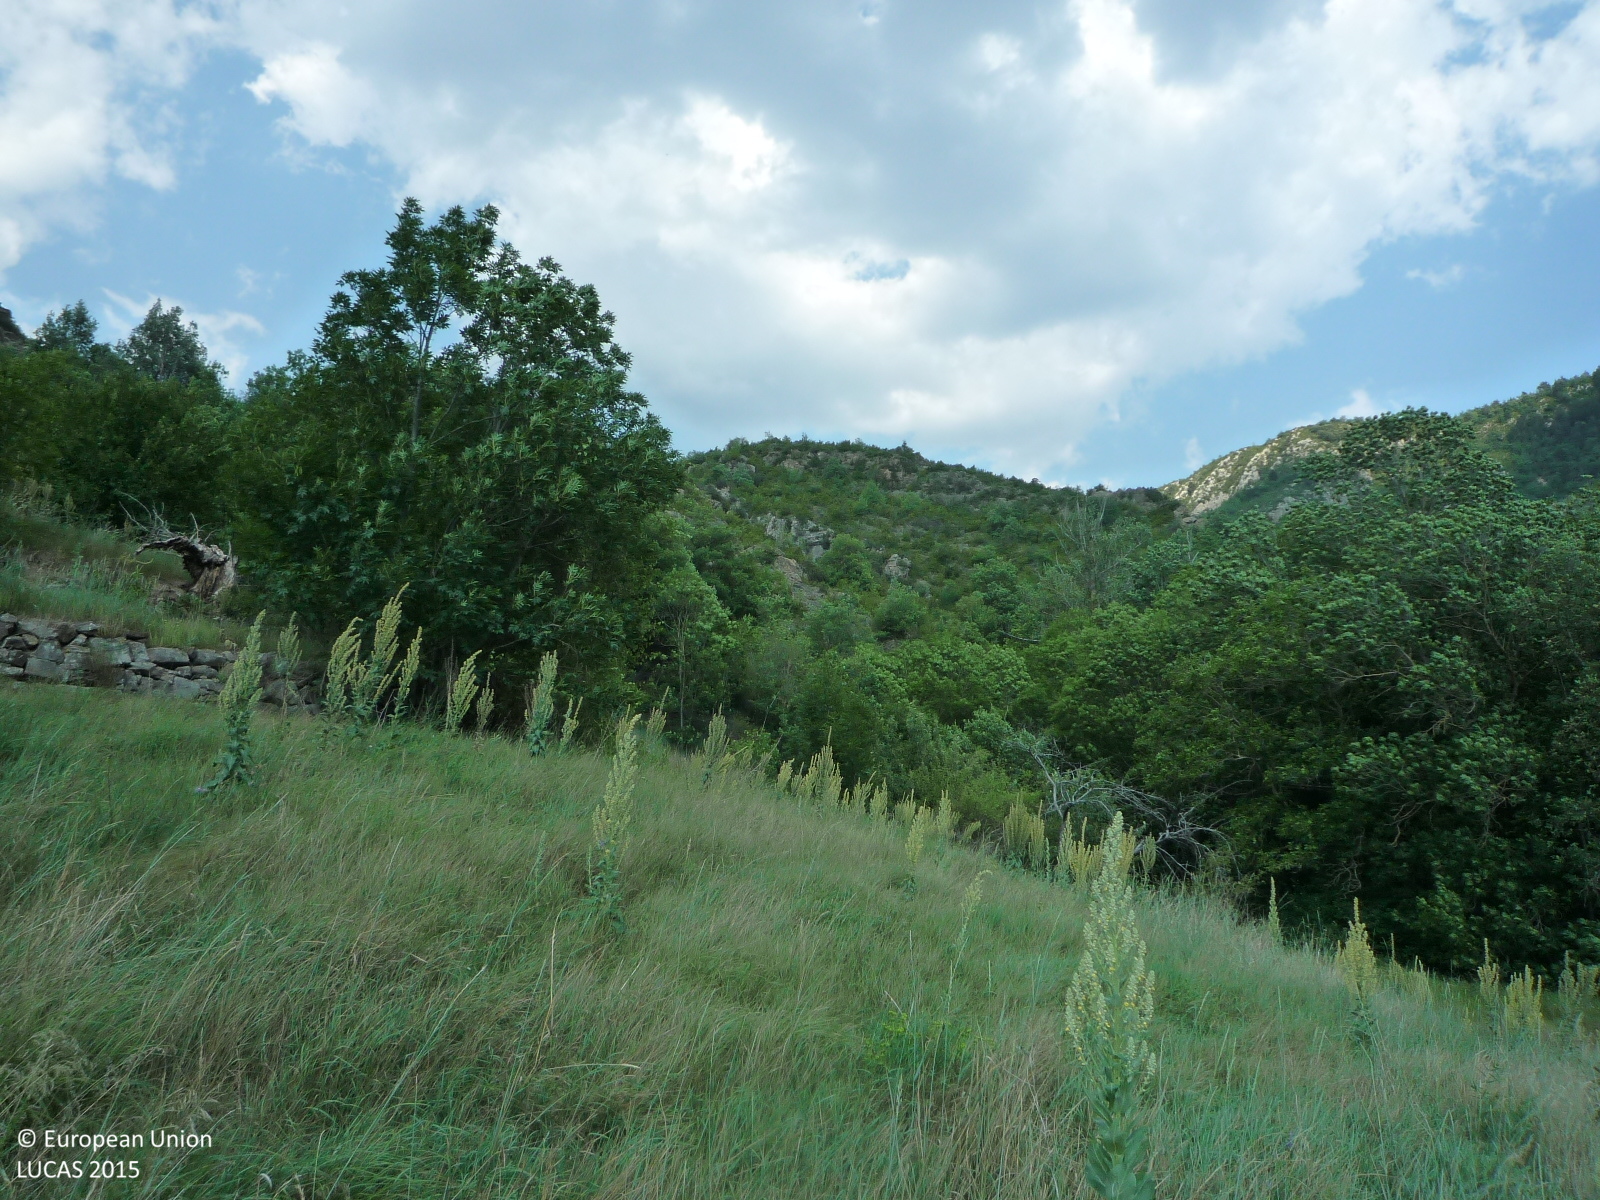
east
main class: Woodland
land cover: Broadleaved woodland
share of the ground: > 75 %
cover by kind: broadleaved forest trees 70 %, shrubs 30 %
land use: Semi-natural and natural areas not in use
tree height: < 5 m
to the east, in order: Broadleaved woodland; Rock outcrops; Other mixed woodland; Rivers and streams; Other mixed woodland; Rock outcrops; Broadleaved woodland; Rock outcrops; Broadleaved woodland; Rock outcrops; Broadleaved woodland
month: June
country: ES
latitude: 42.3648
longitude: 1.6689
